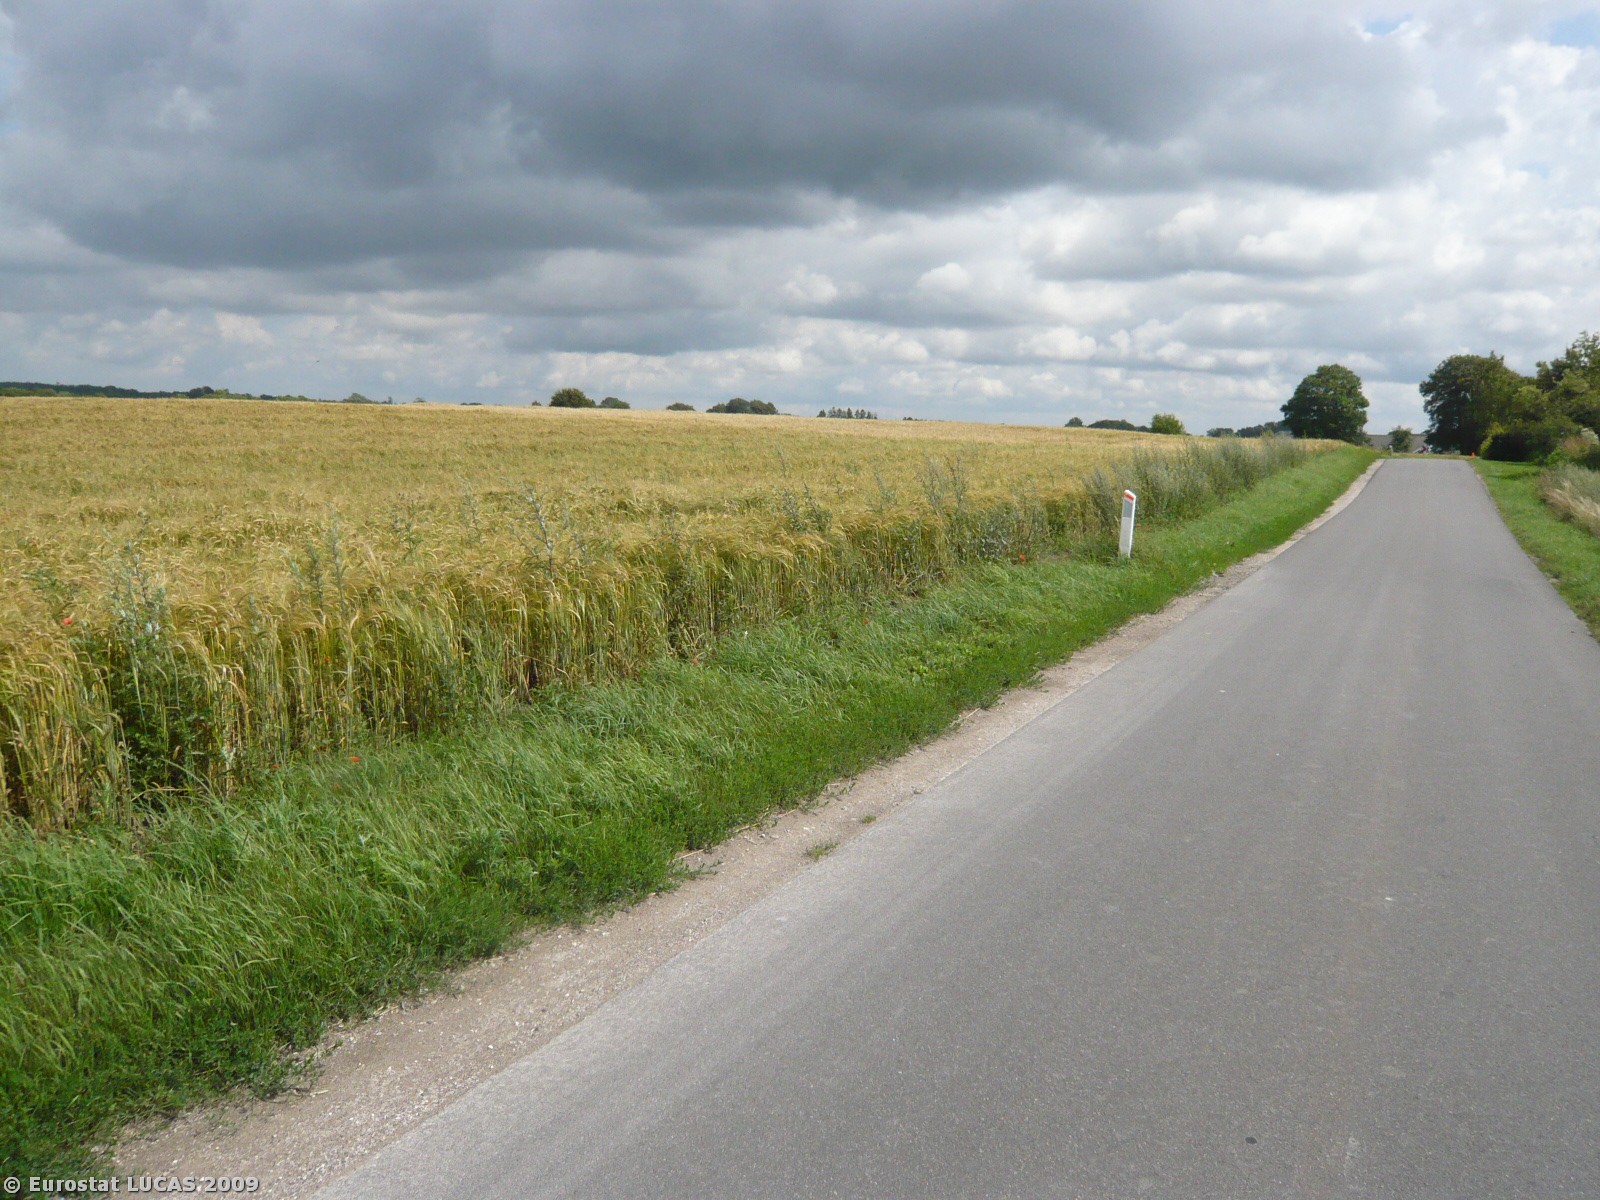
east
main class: Cropland
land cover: Rape and turnip rape
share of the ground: > 75 %
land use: Agriculture (excluding fallow land and kitchen gardens)
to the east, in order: Rape and turnip rape; Grass margins; Ditches and canals; Paved roads, cycling and walking lanes; Grass margins; Barley
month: July
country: DK
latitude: 55.5092
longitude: 11.8511
